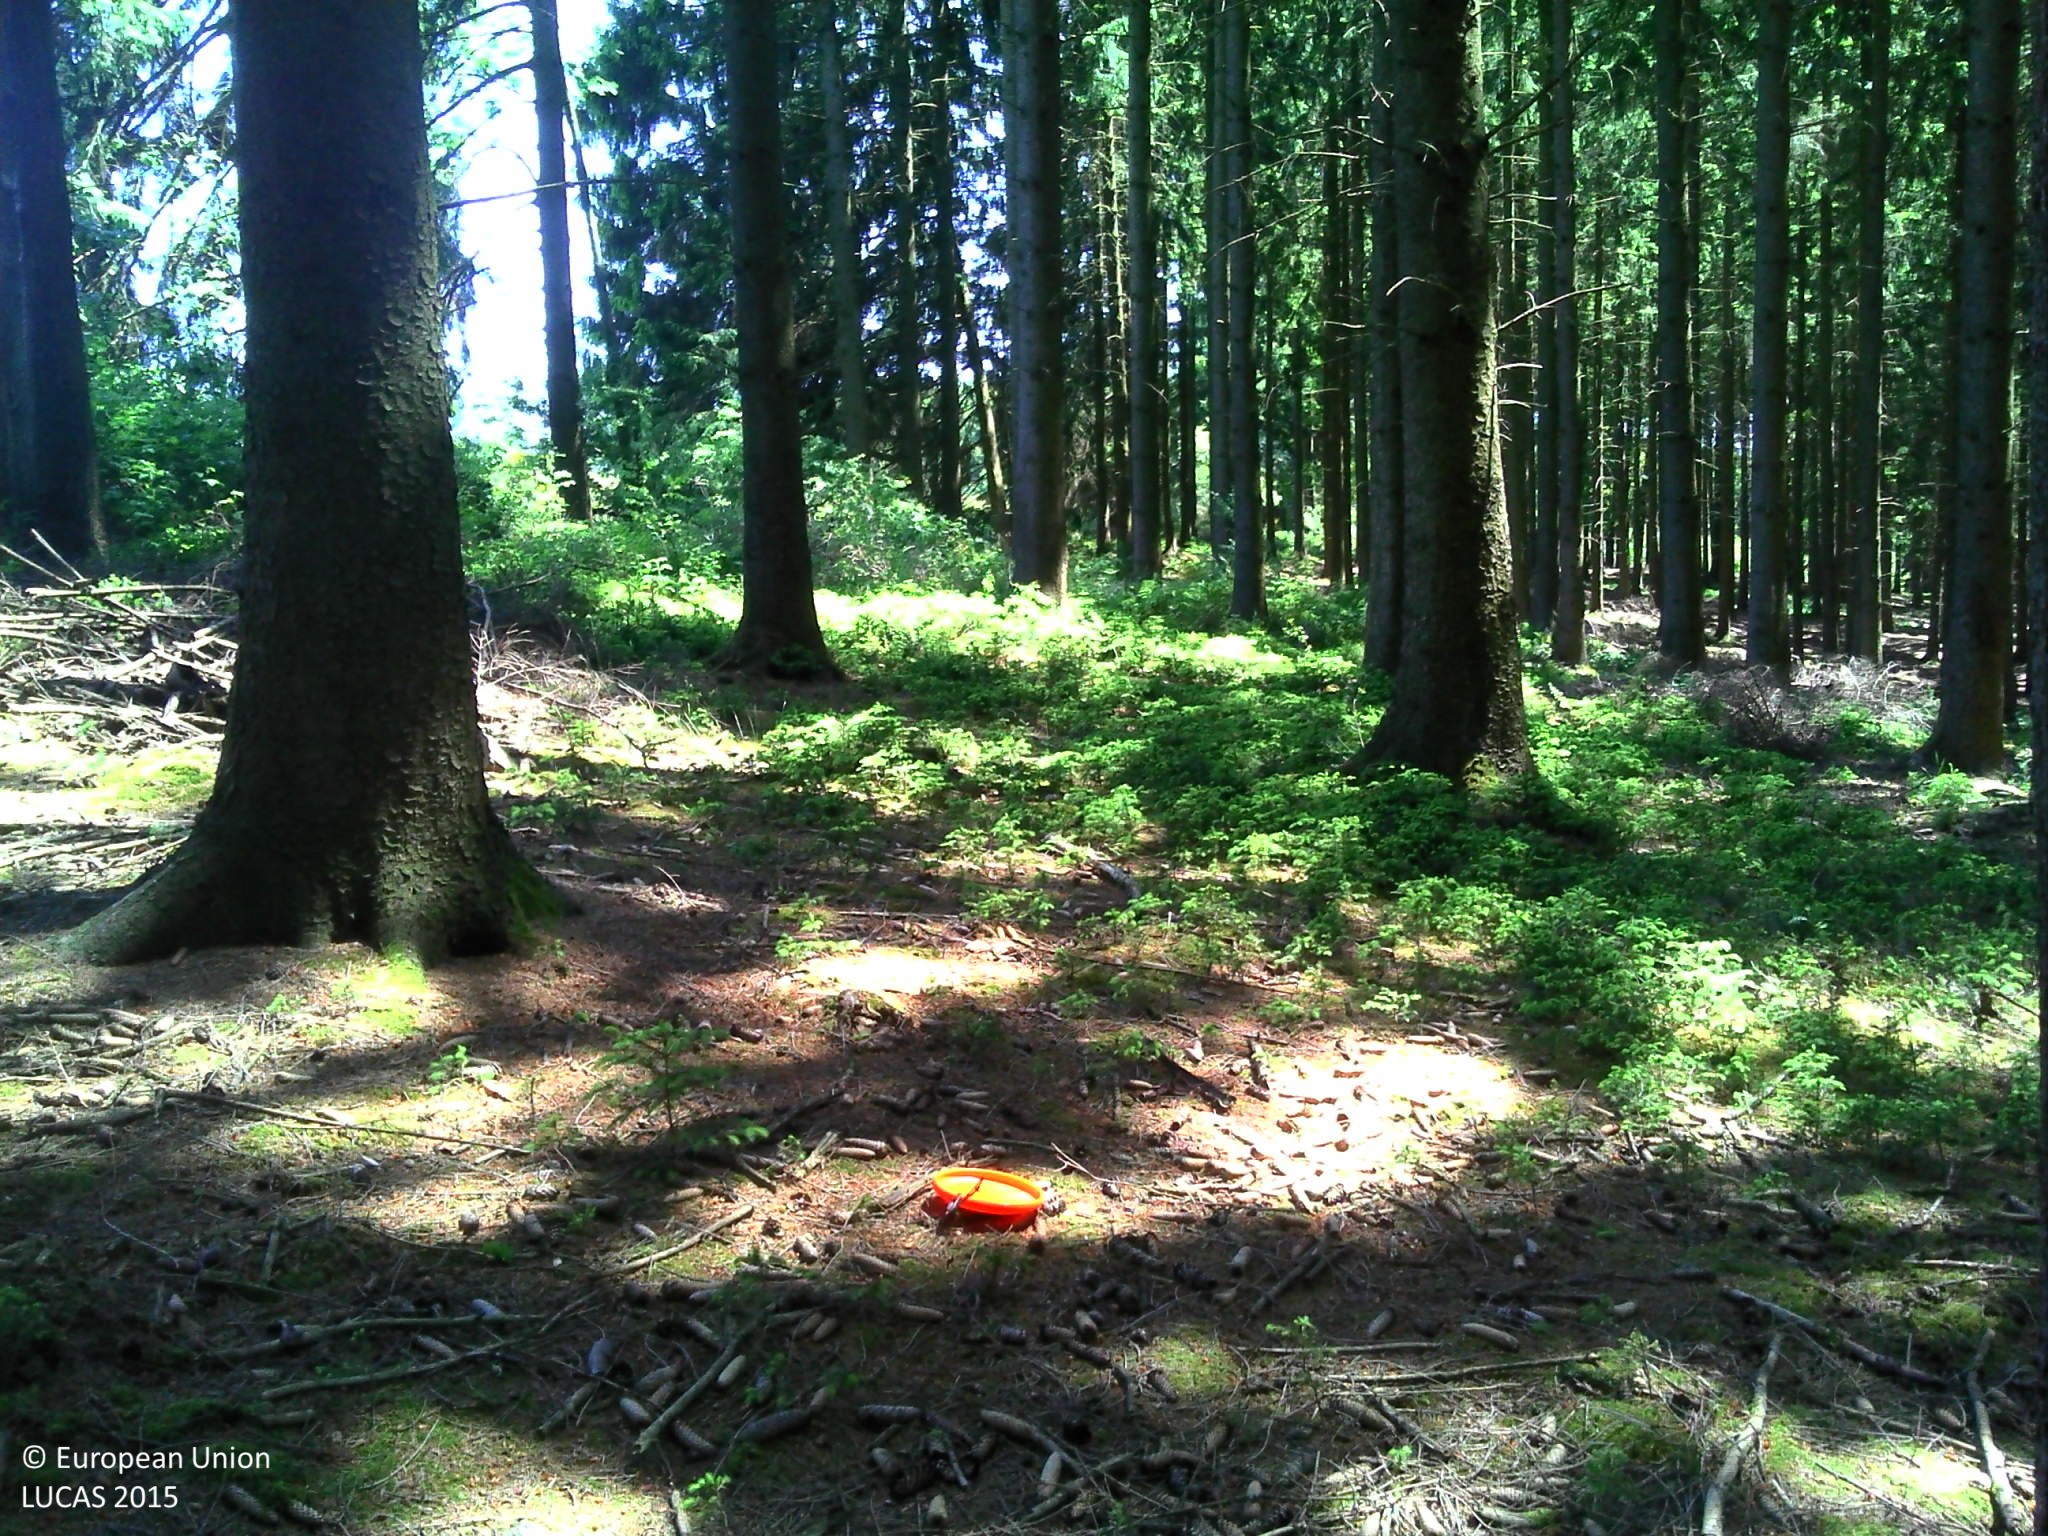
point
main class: Woodland
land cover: Spruce dominated coniferous woodland
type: exotic forest
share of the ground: > 75 %
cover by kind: coniferous forest trees 95 %, lichens and mosses 5 %
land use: Forestry
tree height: > 5 m
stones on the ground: < 10 %
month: June
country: BE
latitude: 50.5193
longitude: 5.7533
